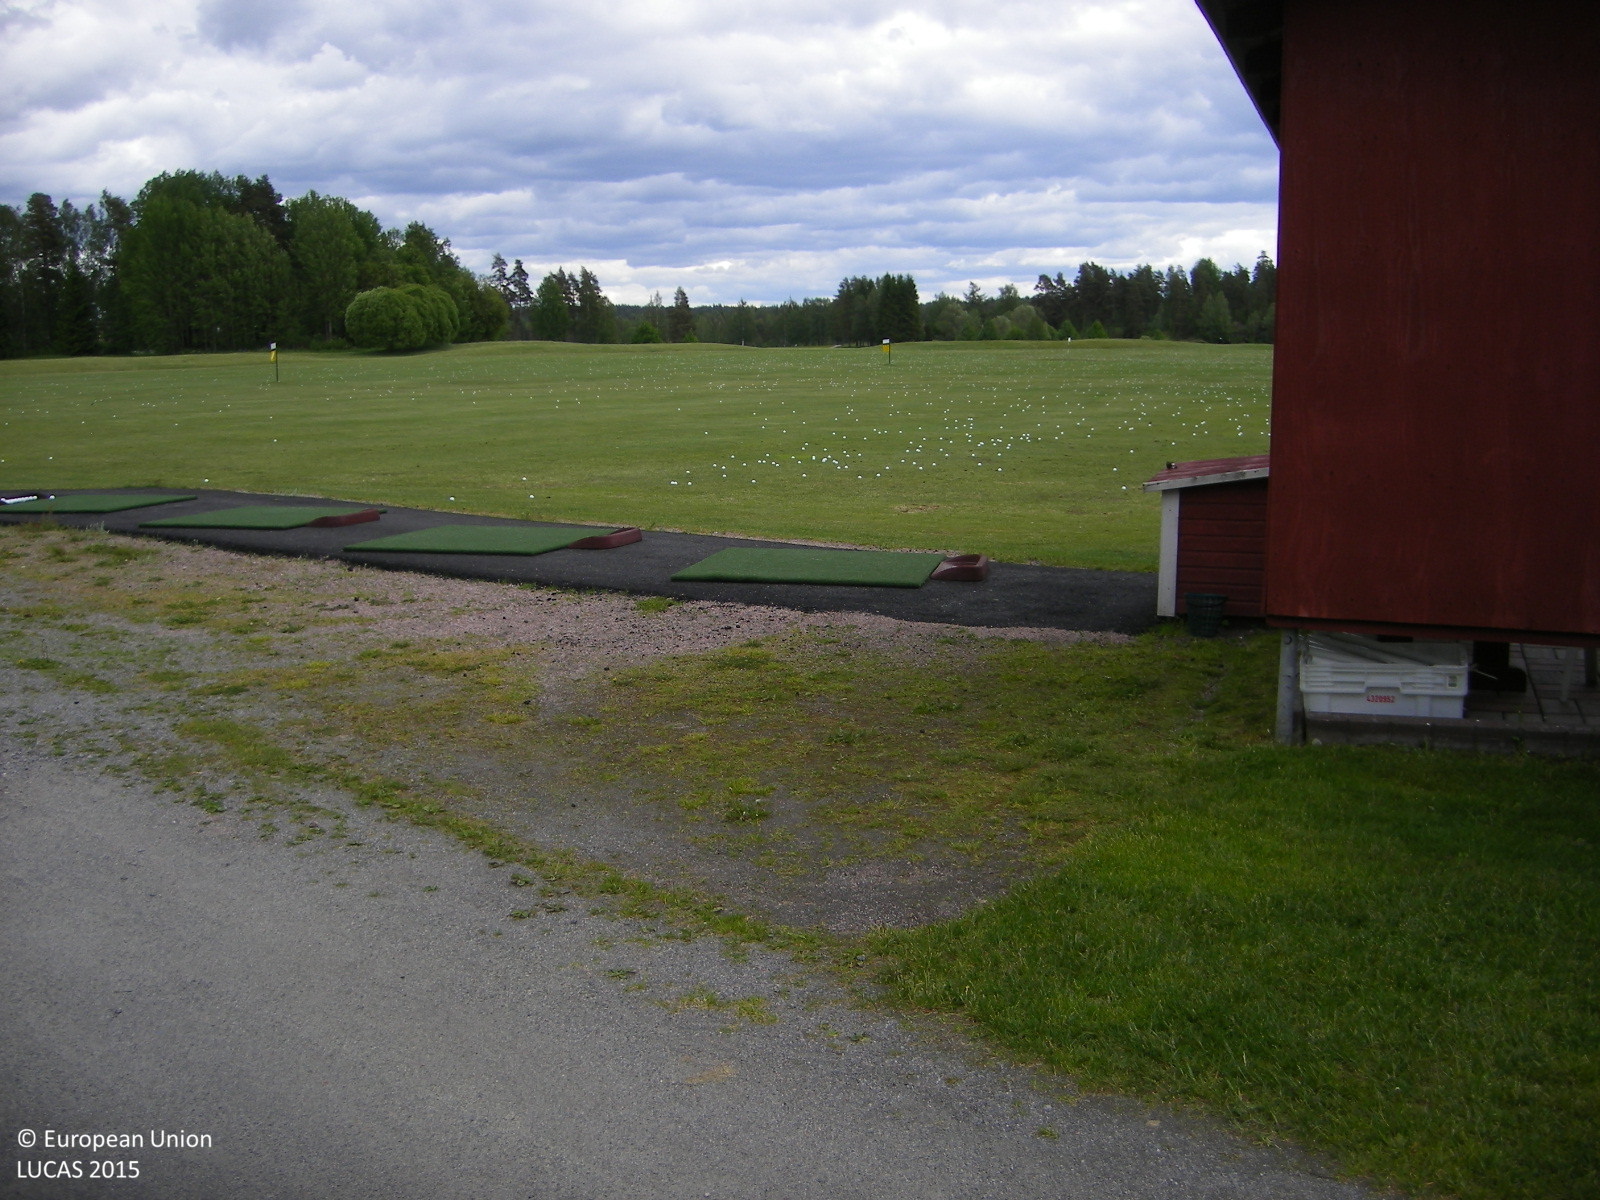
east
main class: Grassland
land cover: Grassland without tree/shrub cover
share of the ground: > 75 %
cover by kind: herbaceous plants 100 %
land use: Sport
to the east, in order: Grassland without tree/shrub cover; Broadleaved woodland; Grassland without tree/shrub cover; Broadleaved woodland
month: June
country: FI
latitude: 60.2237
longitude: 24.0534
